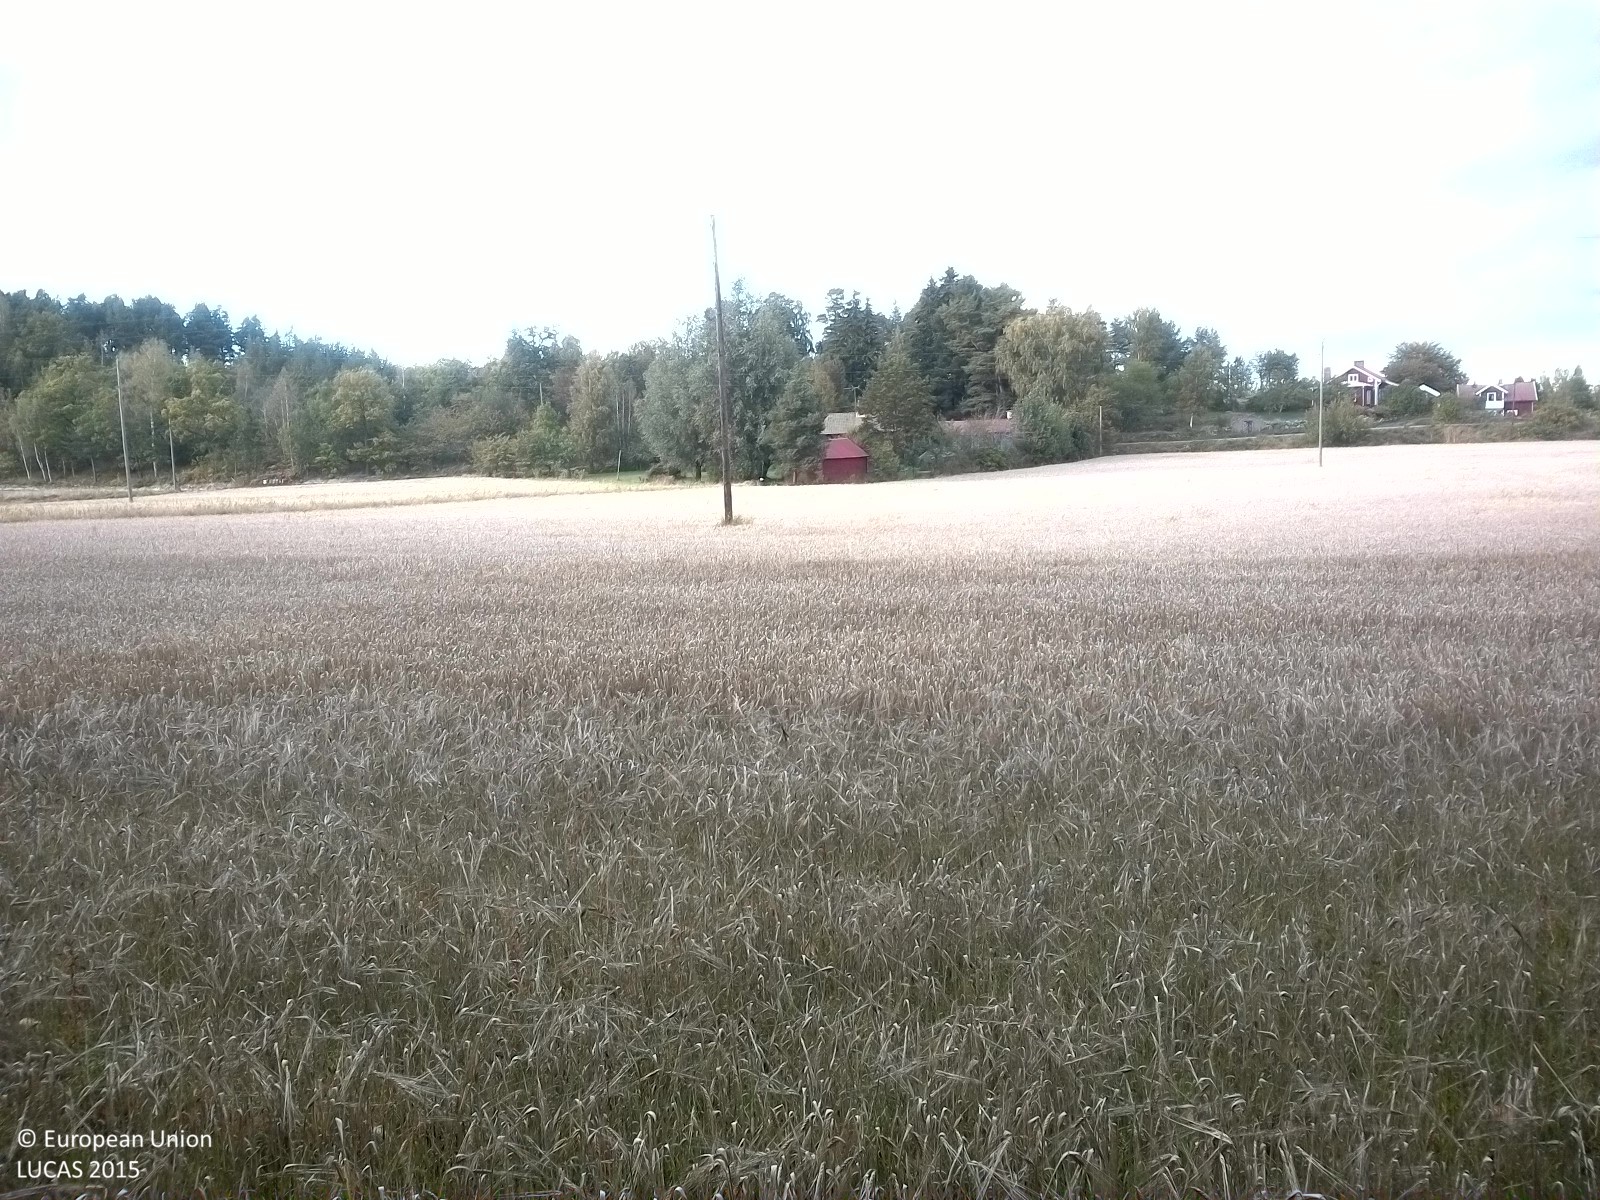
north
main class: Cropland
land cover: Barley
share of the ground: > 75 %
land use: Agriculture (excluding fallow land and kitchen gardens)
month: September
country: SE
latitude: 58.6507
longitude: 17.0110
